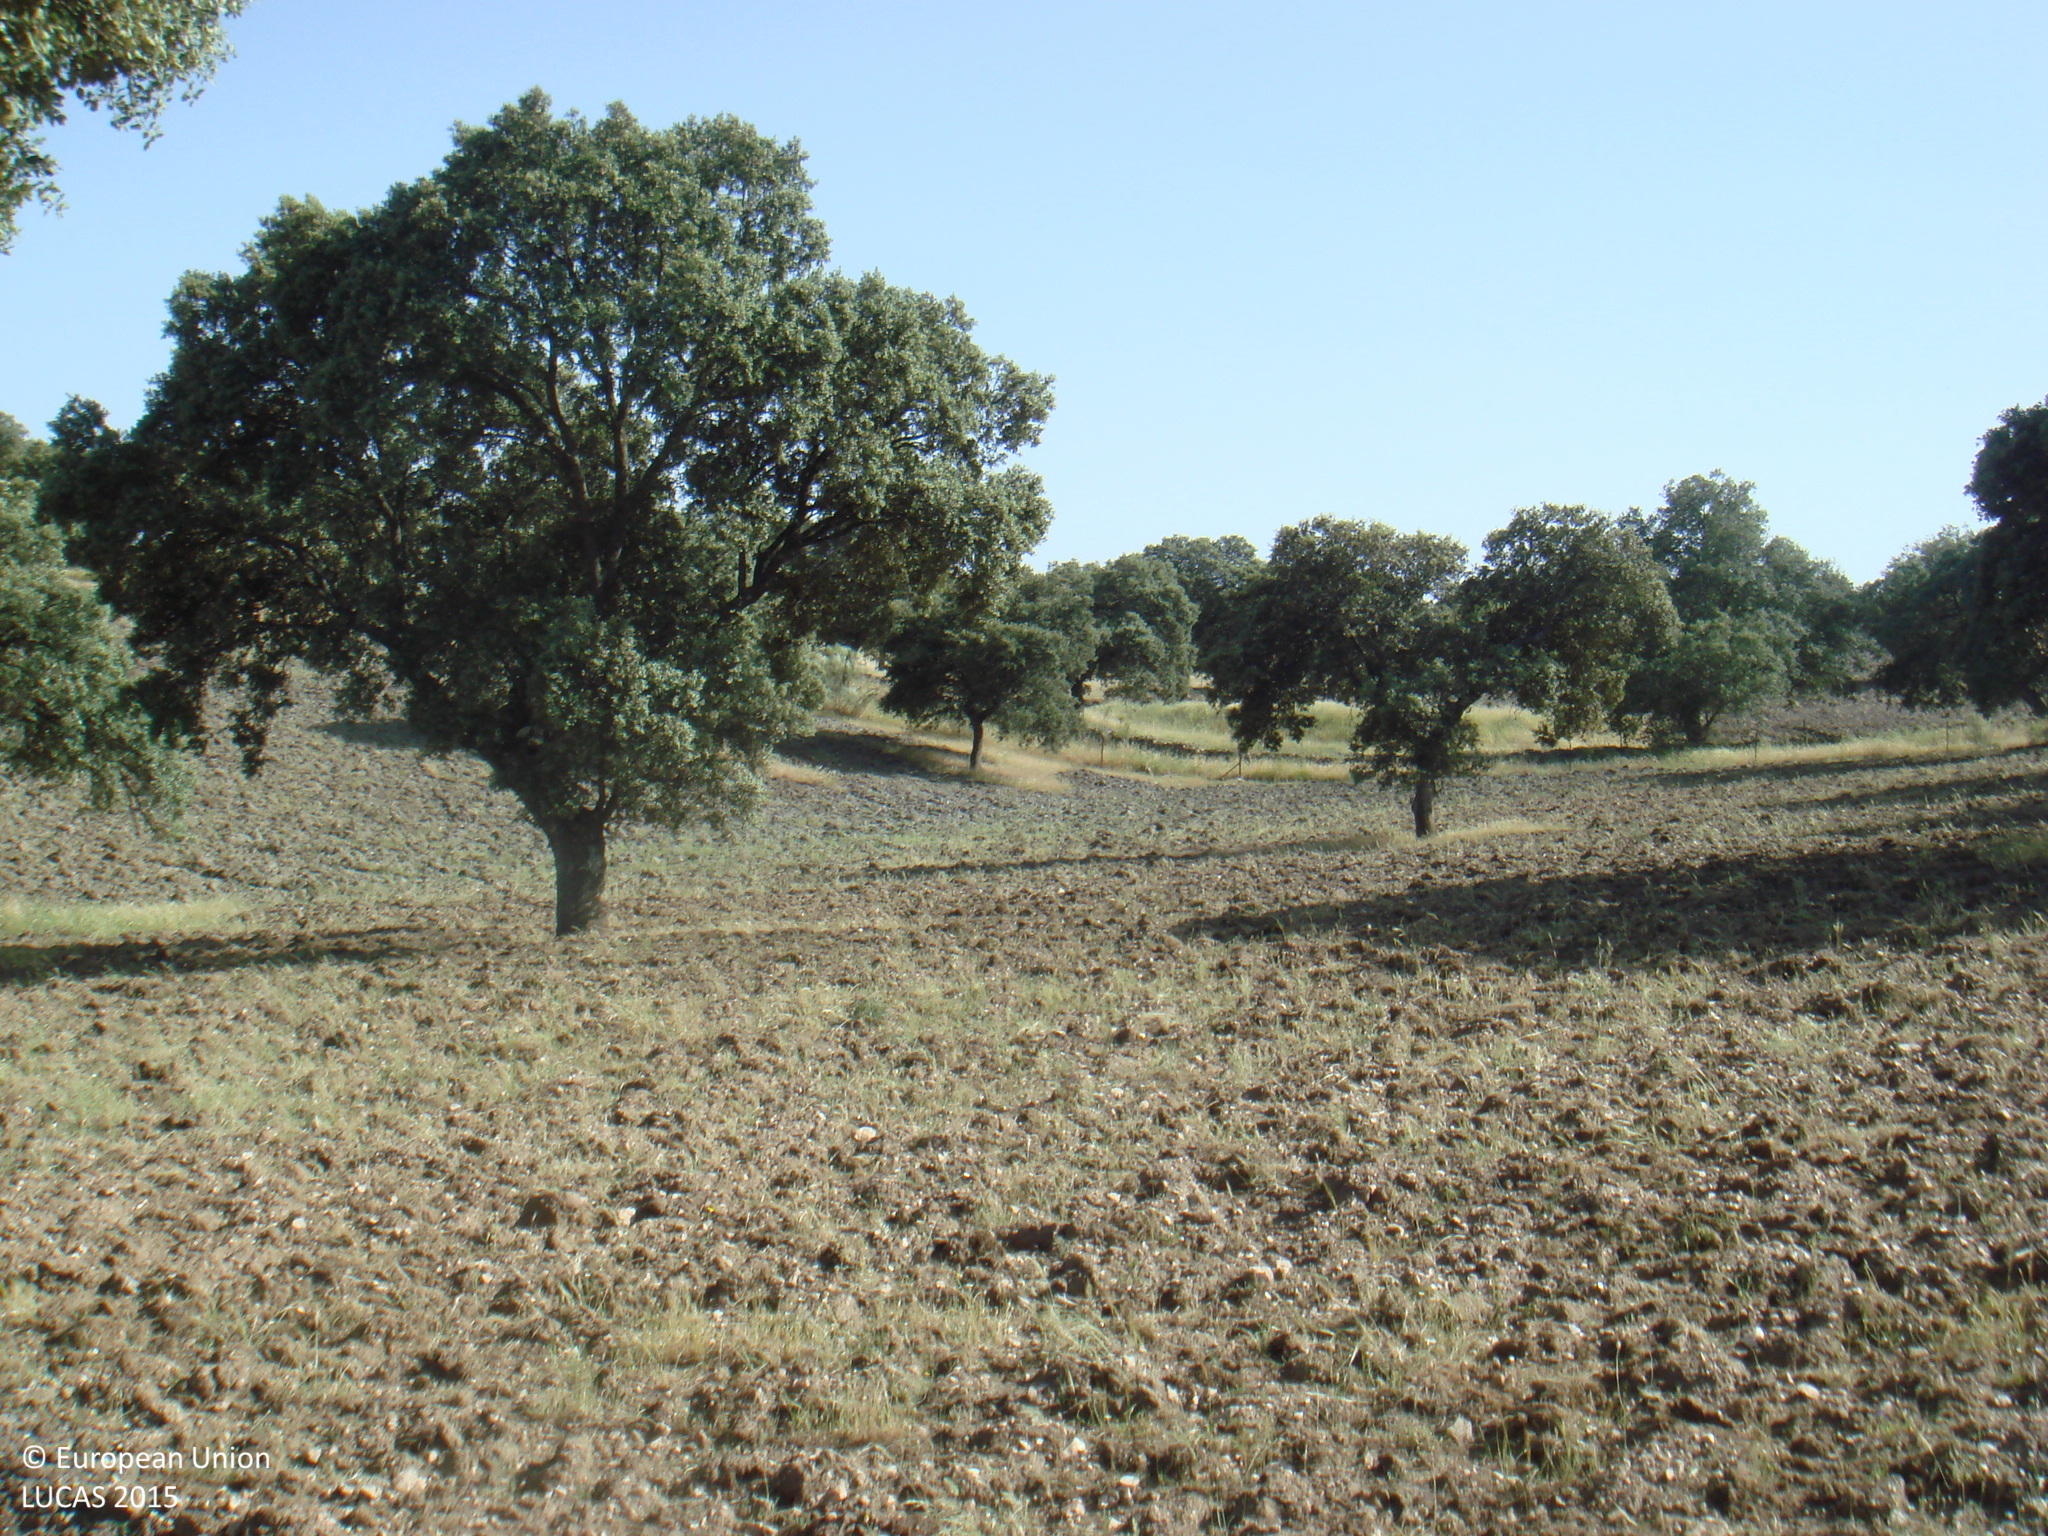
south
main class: Woodland
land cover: Broadleaved woodland
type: broadleaved evergreen forest
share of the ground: 25 - 50 %
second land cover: Spontaneously vegetated surfaces
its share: 10 - 25 %
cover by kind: unconsolidated bare surface 45 %, broadleaved forest trees 40 %, herbaceous plants 15 %
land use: Forestry
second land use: Agriculture (excluding fallow land and kitchen gardens)
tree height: > 5 m
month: May
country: ES
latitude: 38.5157
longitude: -4.7852
